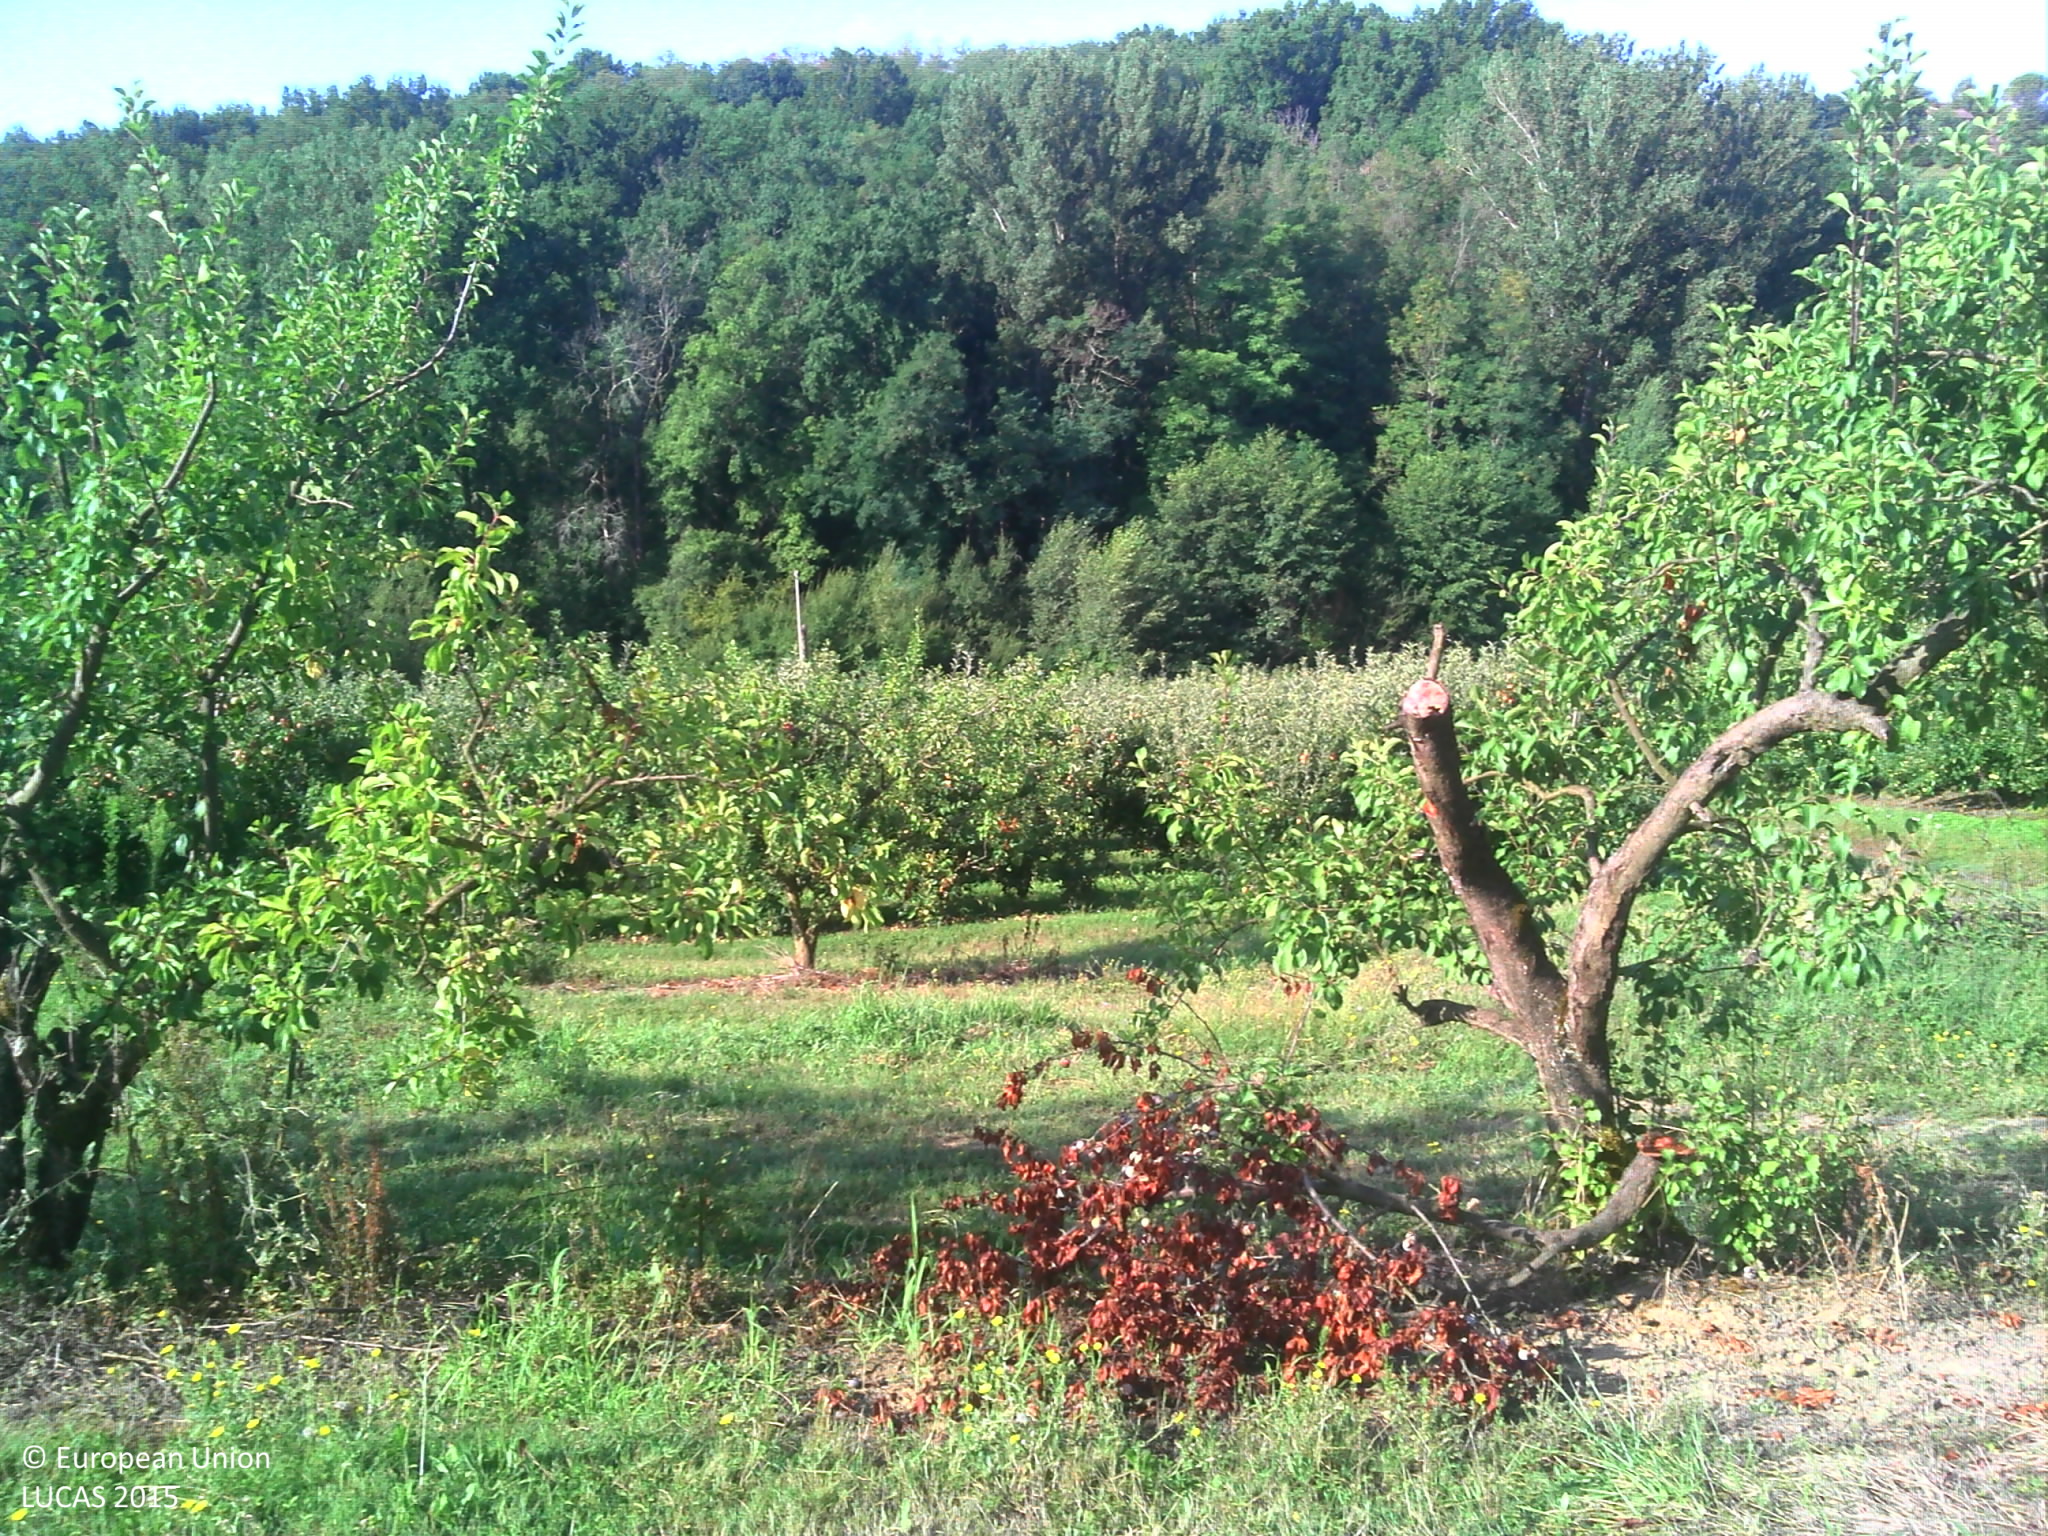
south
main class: Grassland
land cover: Grassland without tree/shrub cover
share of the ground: > 75 %
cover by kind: herbaceous plants 100 %
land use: Agriculture (excluding fallow land and kitchen gardens)
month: August
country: FR
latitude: 44.0970
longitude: 1.3430
